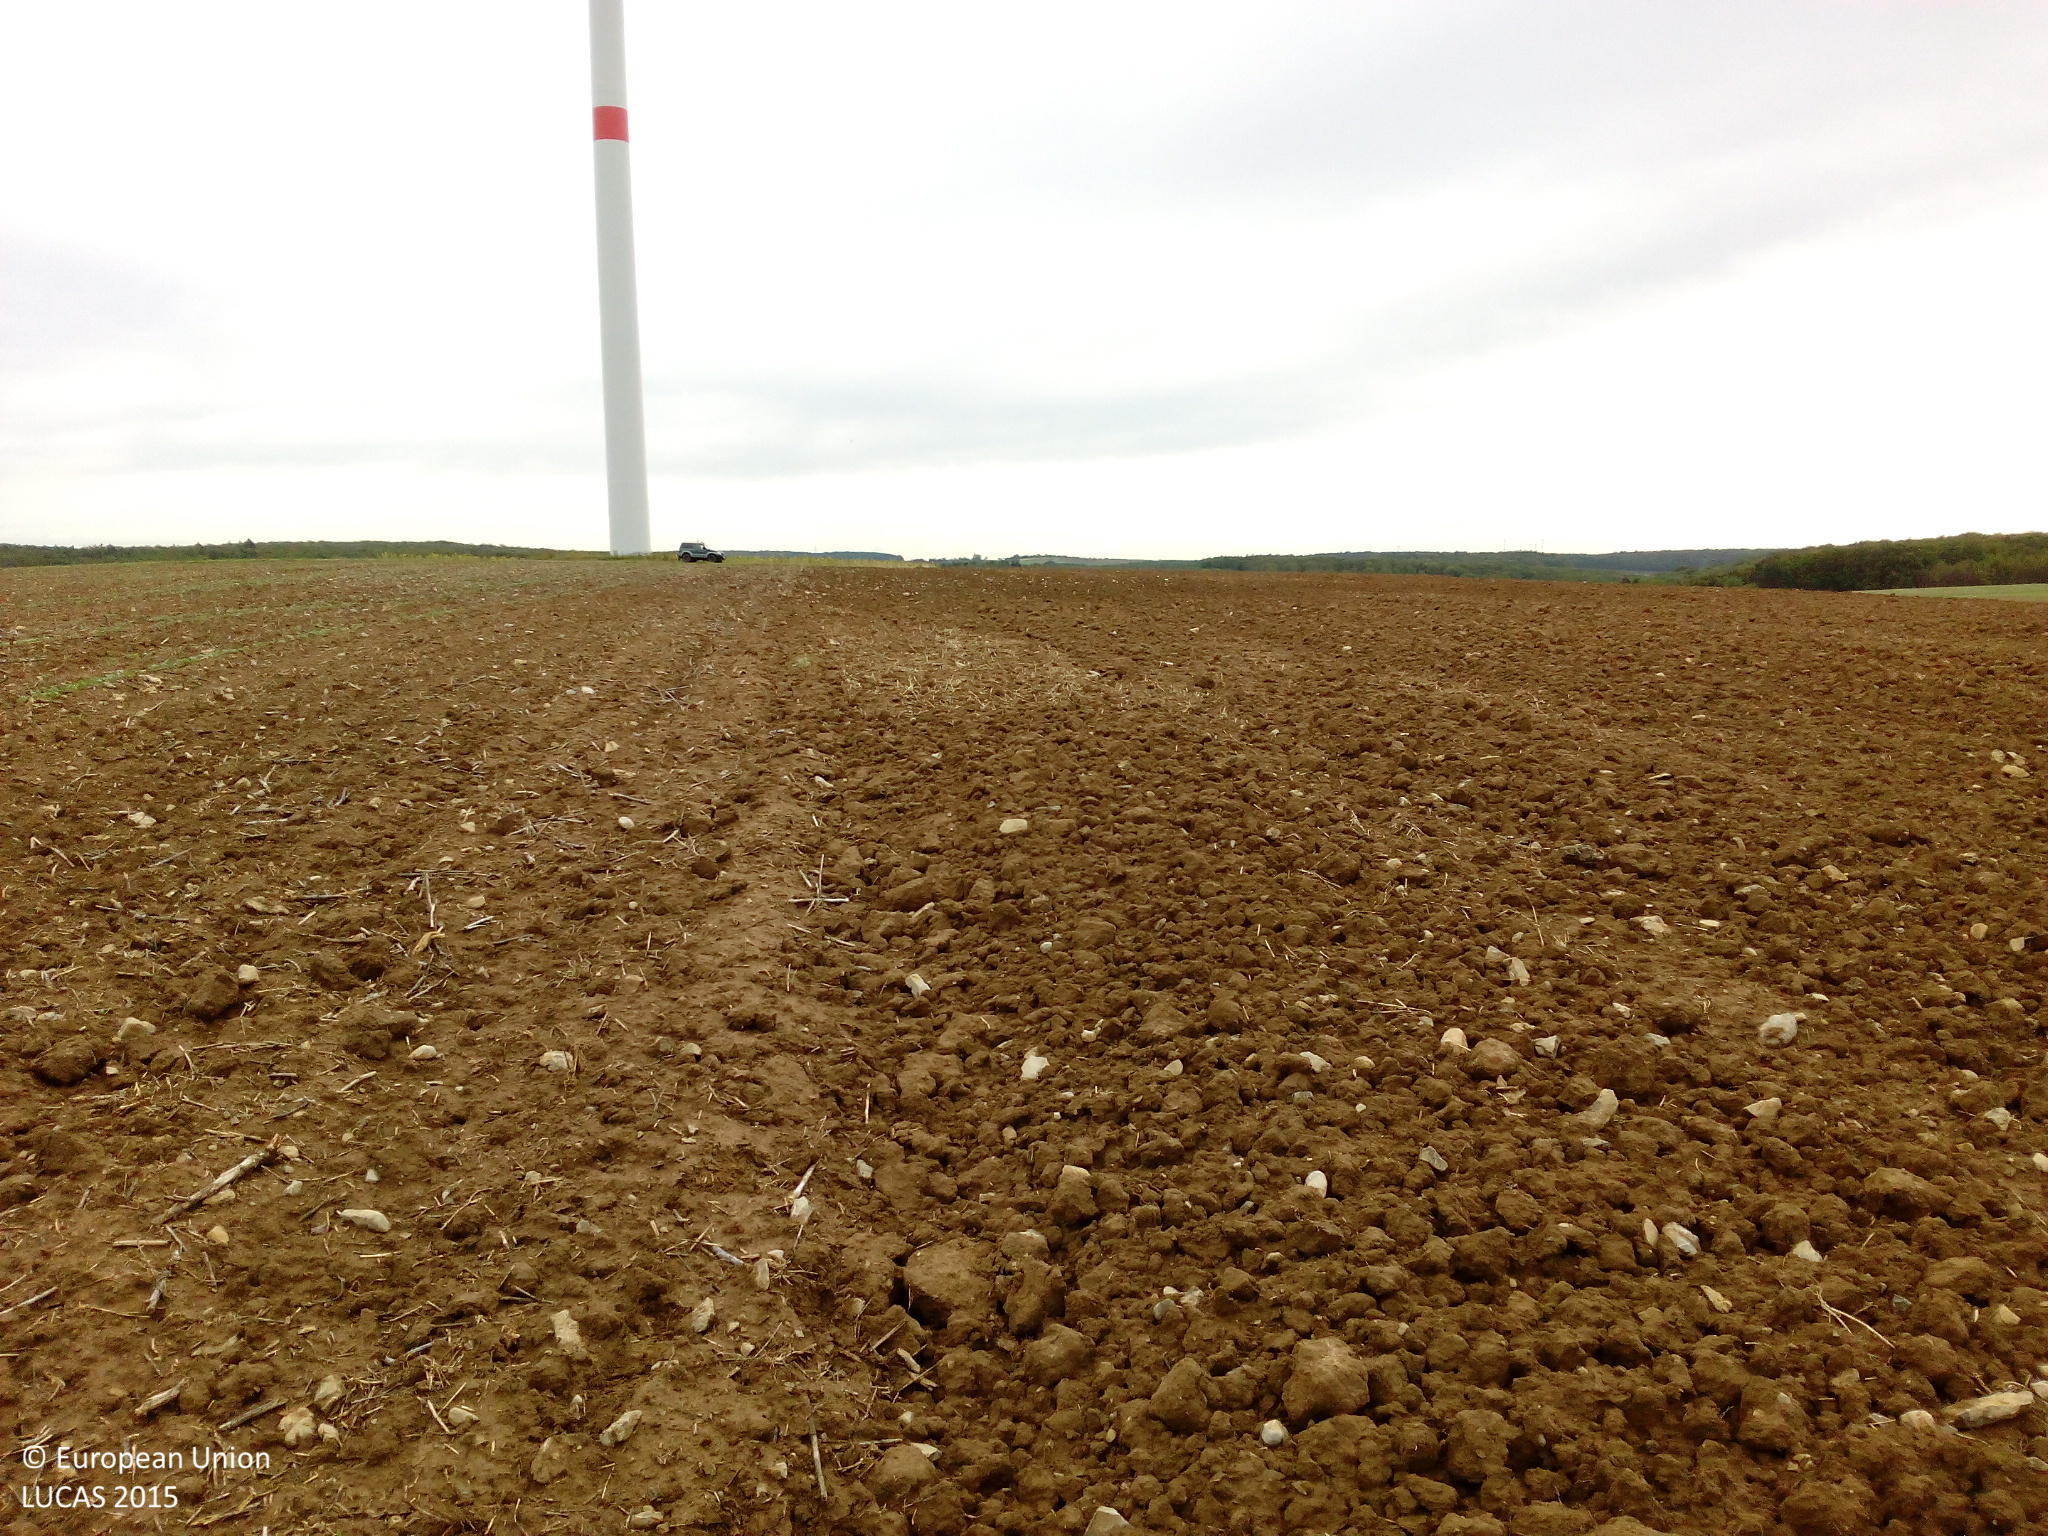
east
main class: Cropland
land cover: Rape and turnip rape
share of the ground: < 10 %
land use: Agriculture (excluding fallow land and kitchen gardens)
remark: Harvested field
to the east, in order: Rape and turnip rape; Other bare soil; Ditches and canals; Paved roads, cycling and walking lanes; Grass margins; Other leguminous and mixtures for fodder
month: September
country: DE
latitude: 50.0583
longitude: 9.9302
